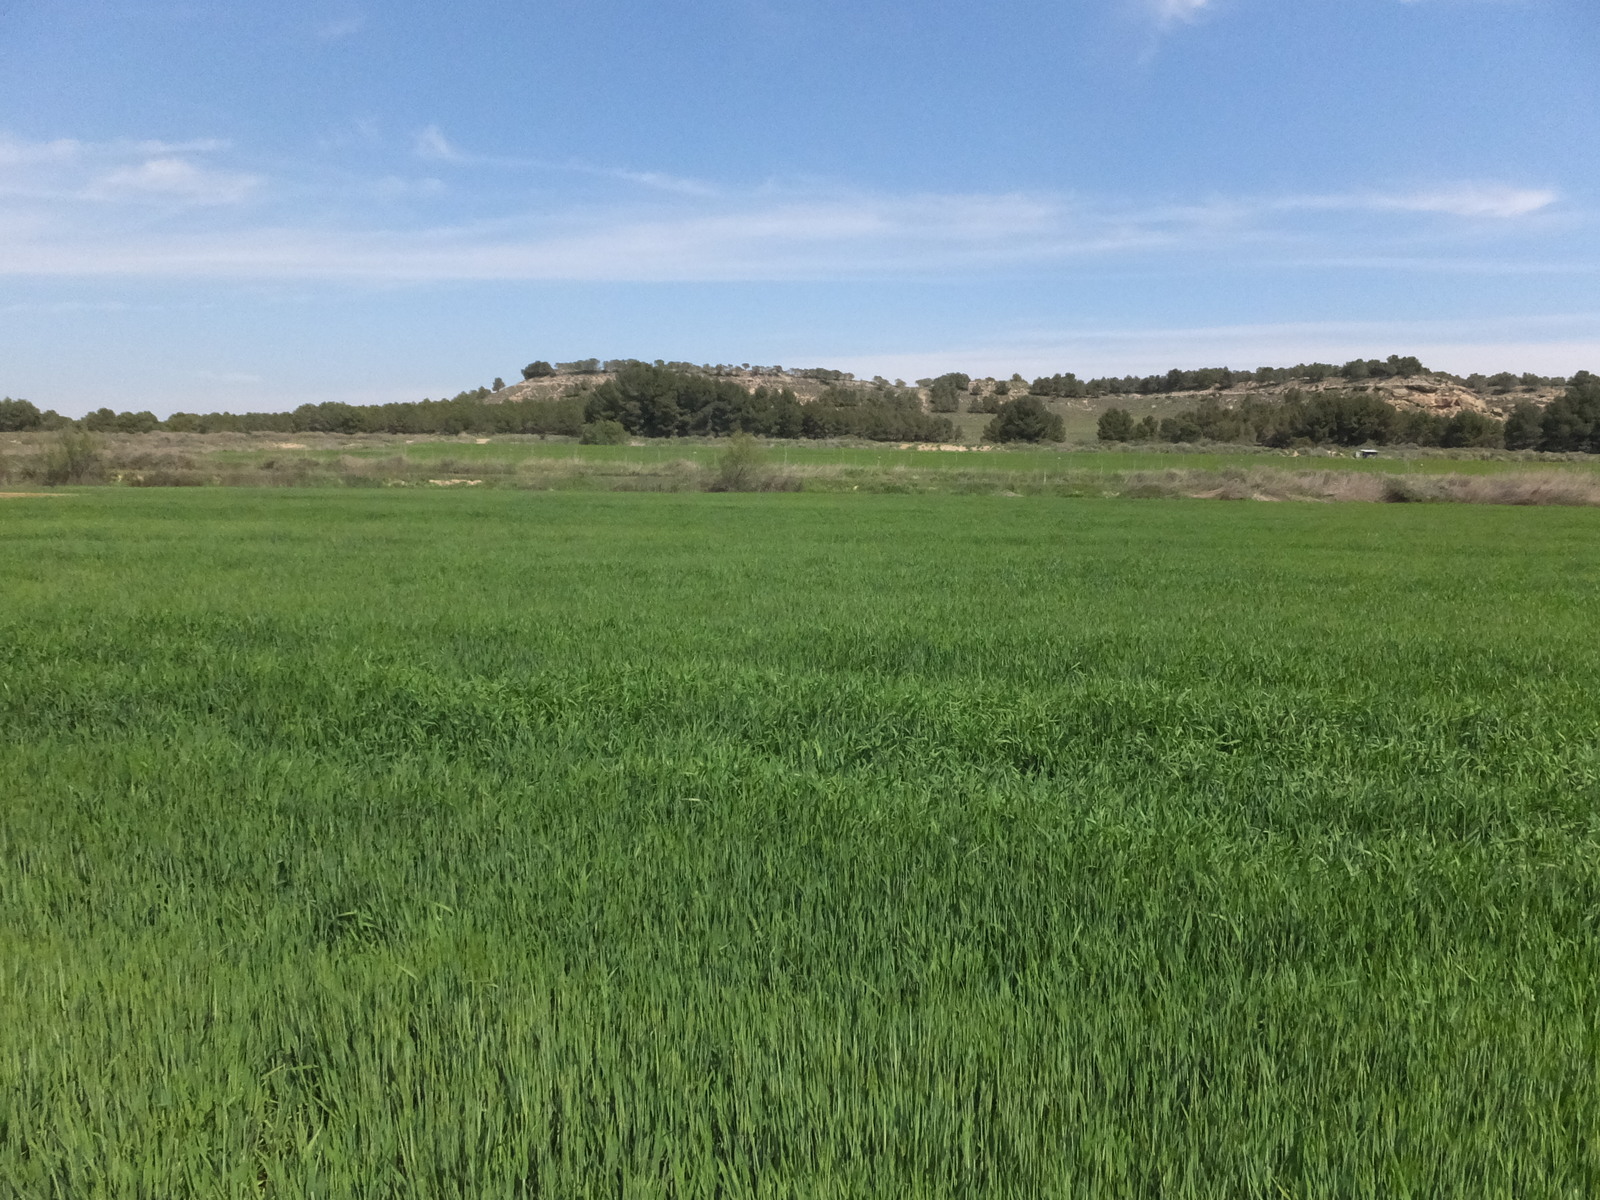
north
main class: Cropland
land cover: Durum wheat
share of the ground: > 75 %
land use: Agriculture (excluding fallow land and kitchen gardens)
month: April
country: ES
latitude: 41.7732
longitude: -0.2077
